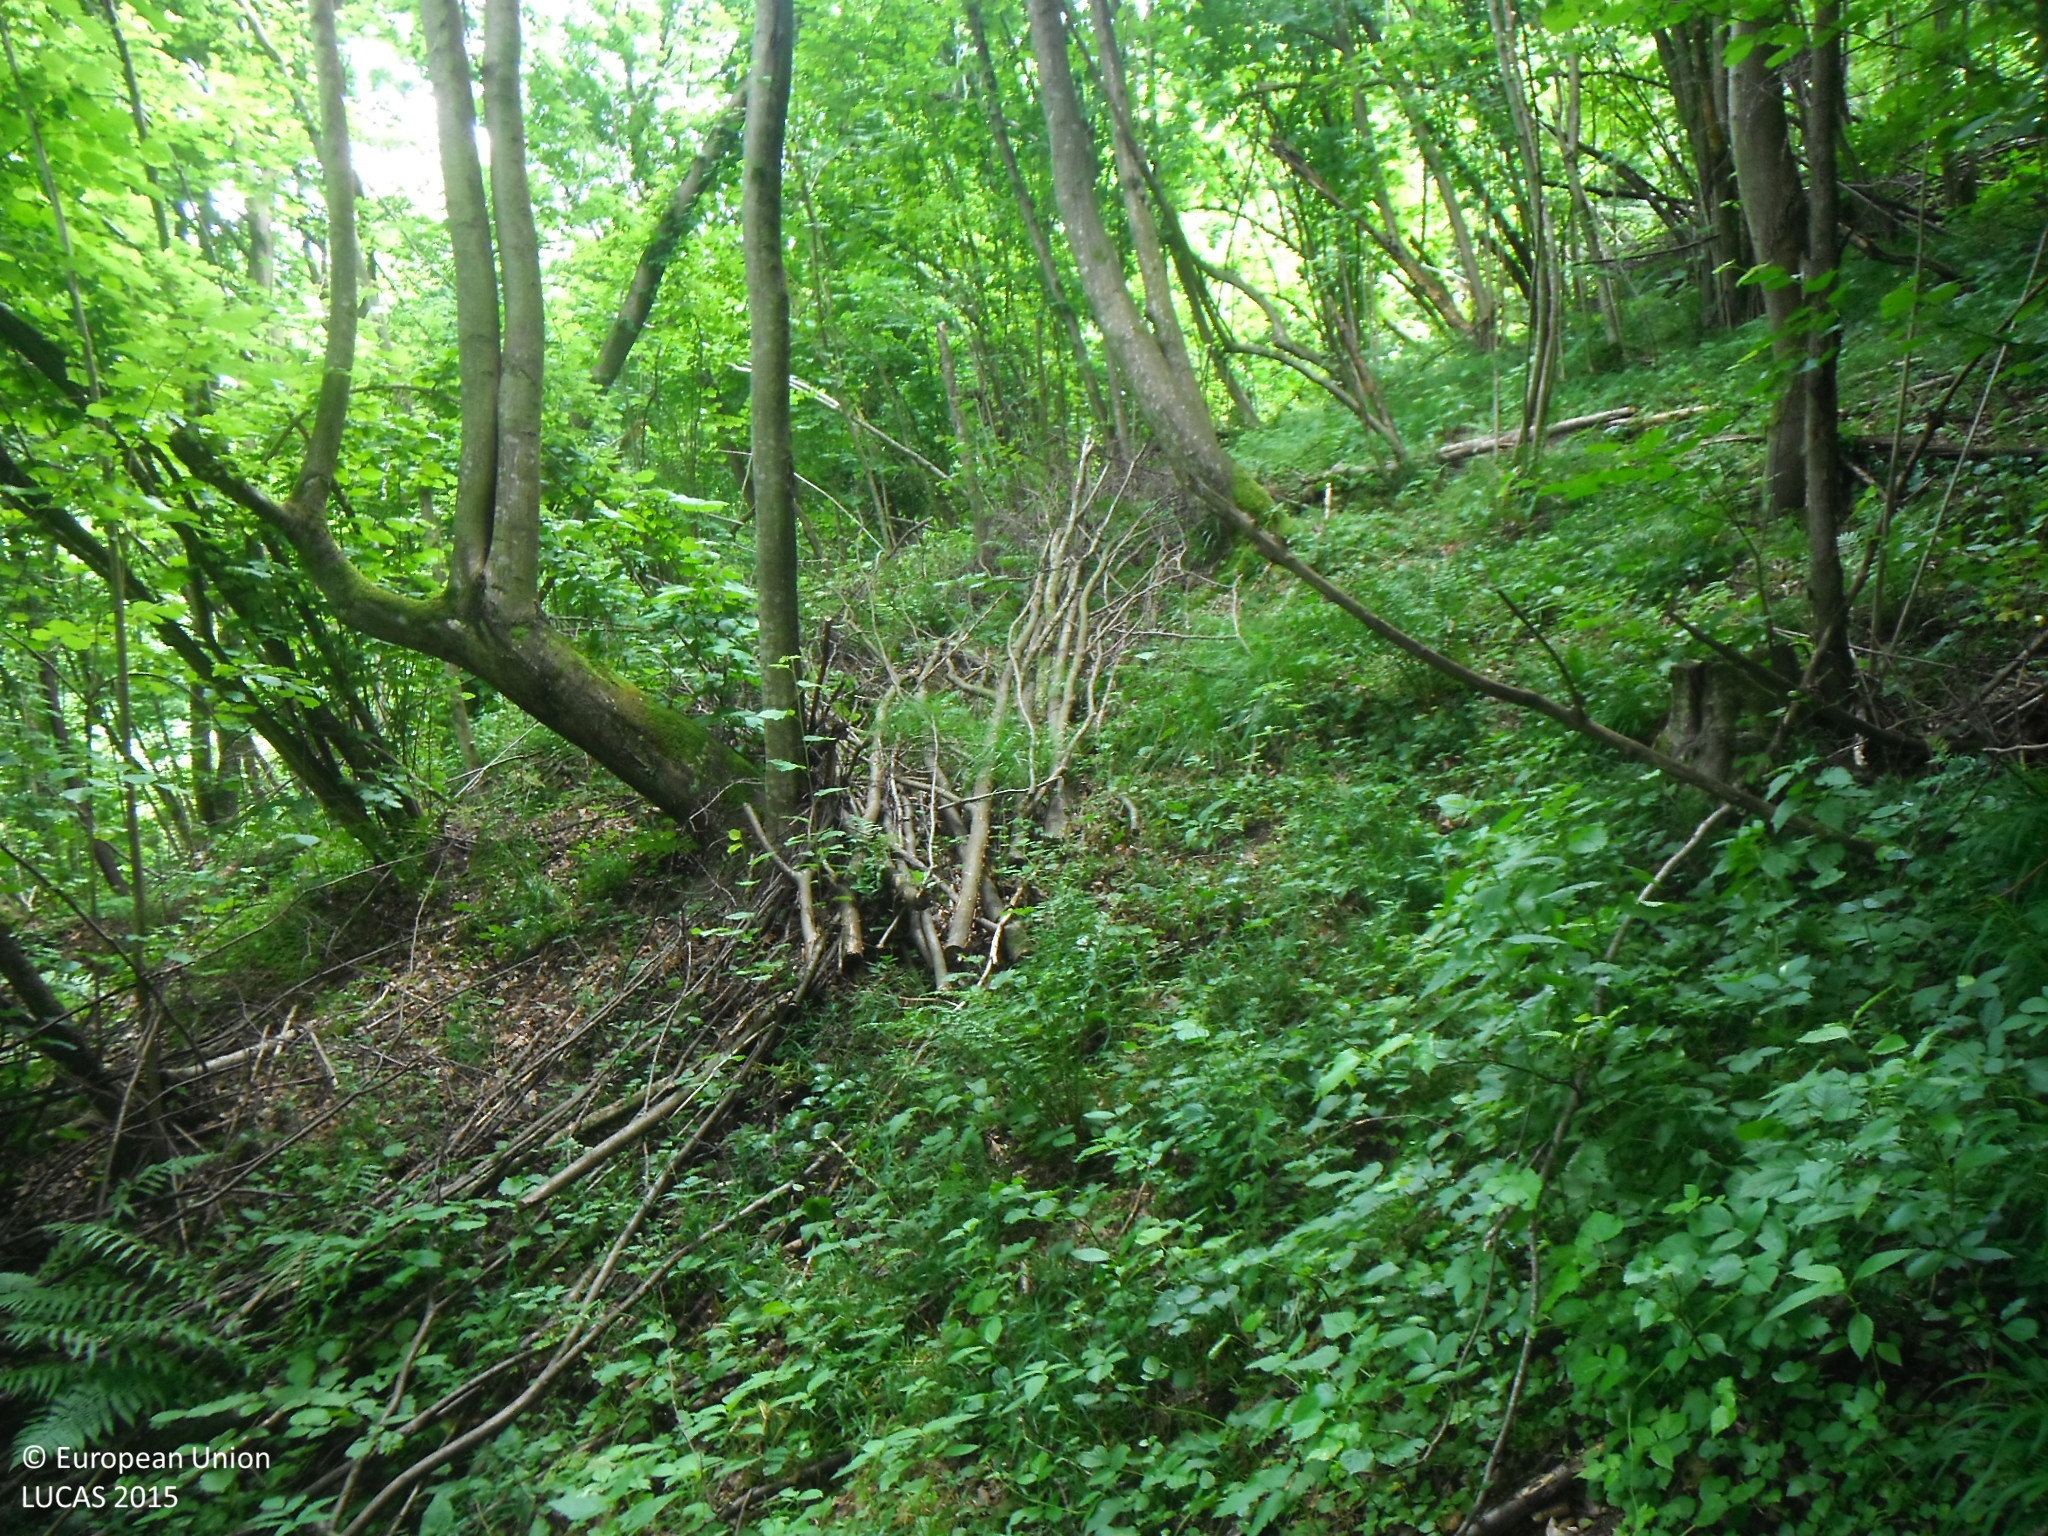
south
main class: Woodland
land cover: Broadleaved woodland
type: beech forest
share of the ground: > 75 %
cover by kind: broadleaved forest trees 90 %, herbaceous plants 5 %, consolidated bare surface 5 %
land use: Forestry
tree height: > 5 m
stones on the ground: < 10 %
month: June
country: SK
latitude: 48.9915
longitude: 21.9307
